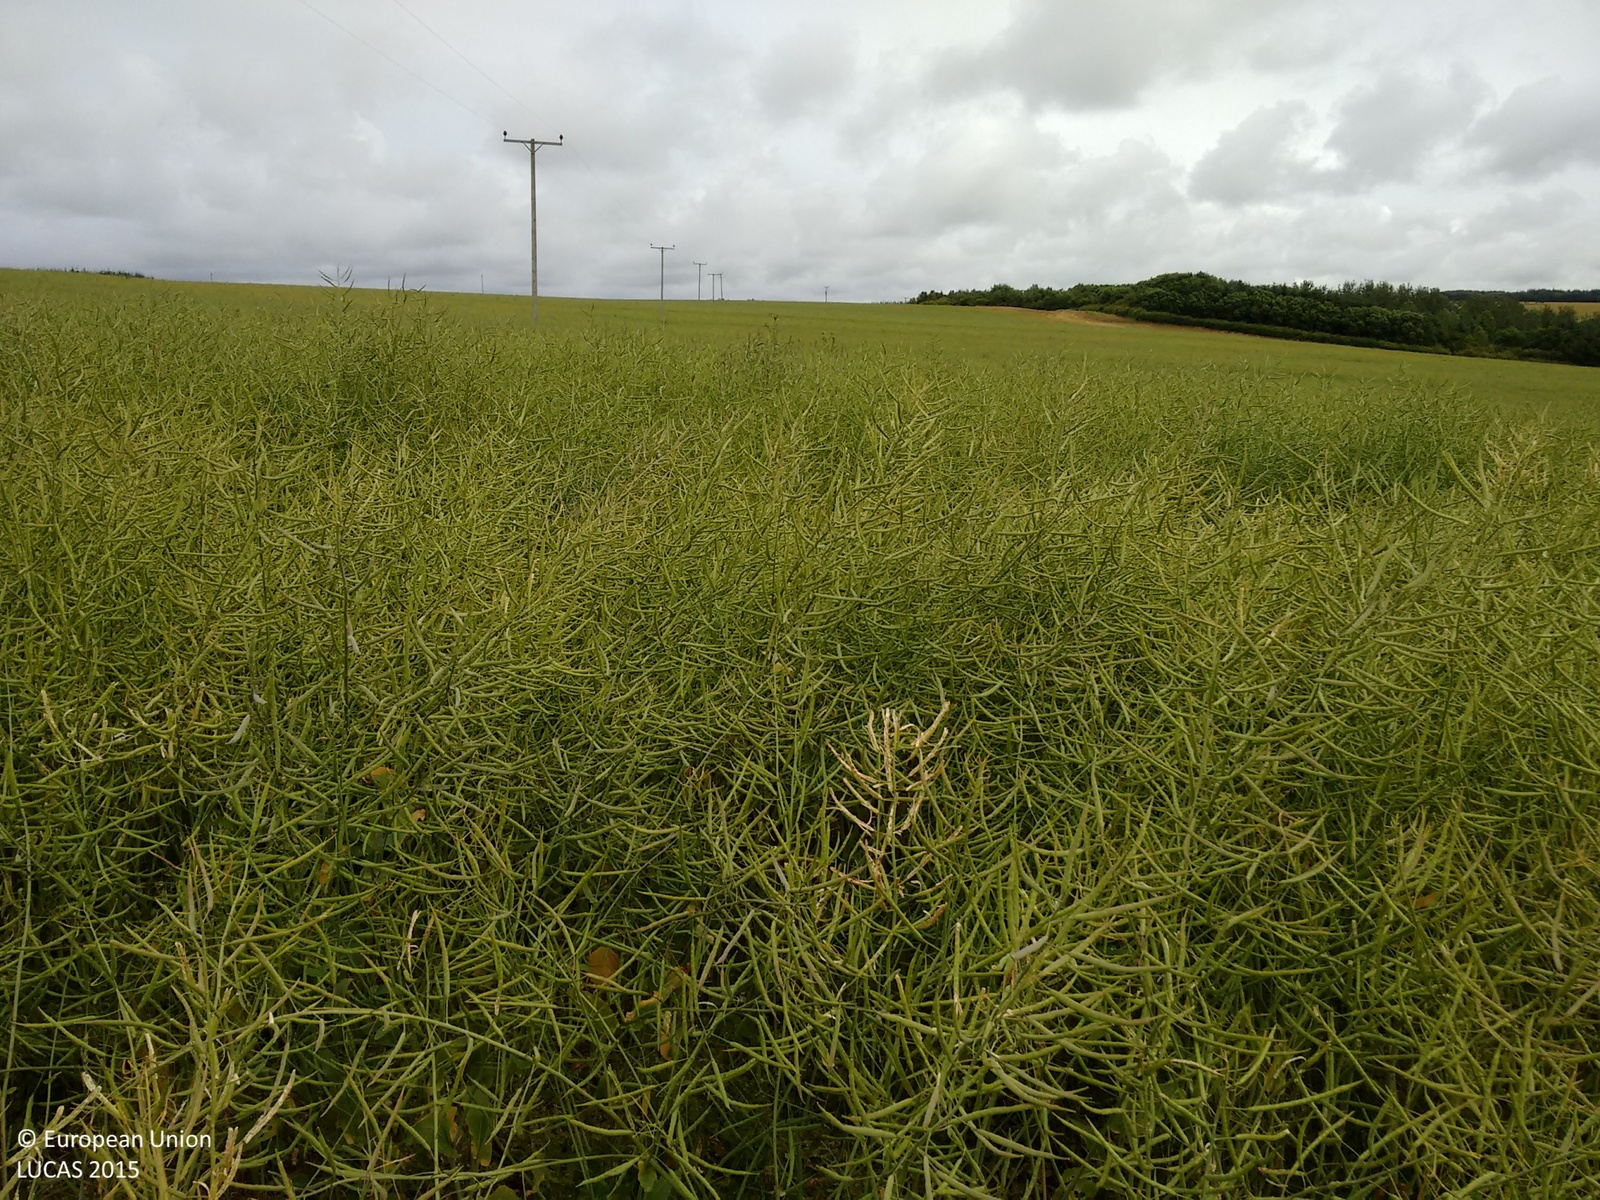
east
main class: Cropland
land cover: Rape and turnip rape
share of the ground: > 75 %
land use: Agriculture (excluding fallow land and kitchen gardens)
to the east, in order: Rape and turnip rape; Grassland without tree/shrub cover; Spruce dominated mixed woodland
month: July
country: GB
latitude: 57.6043
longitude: -2.4181
